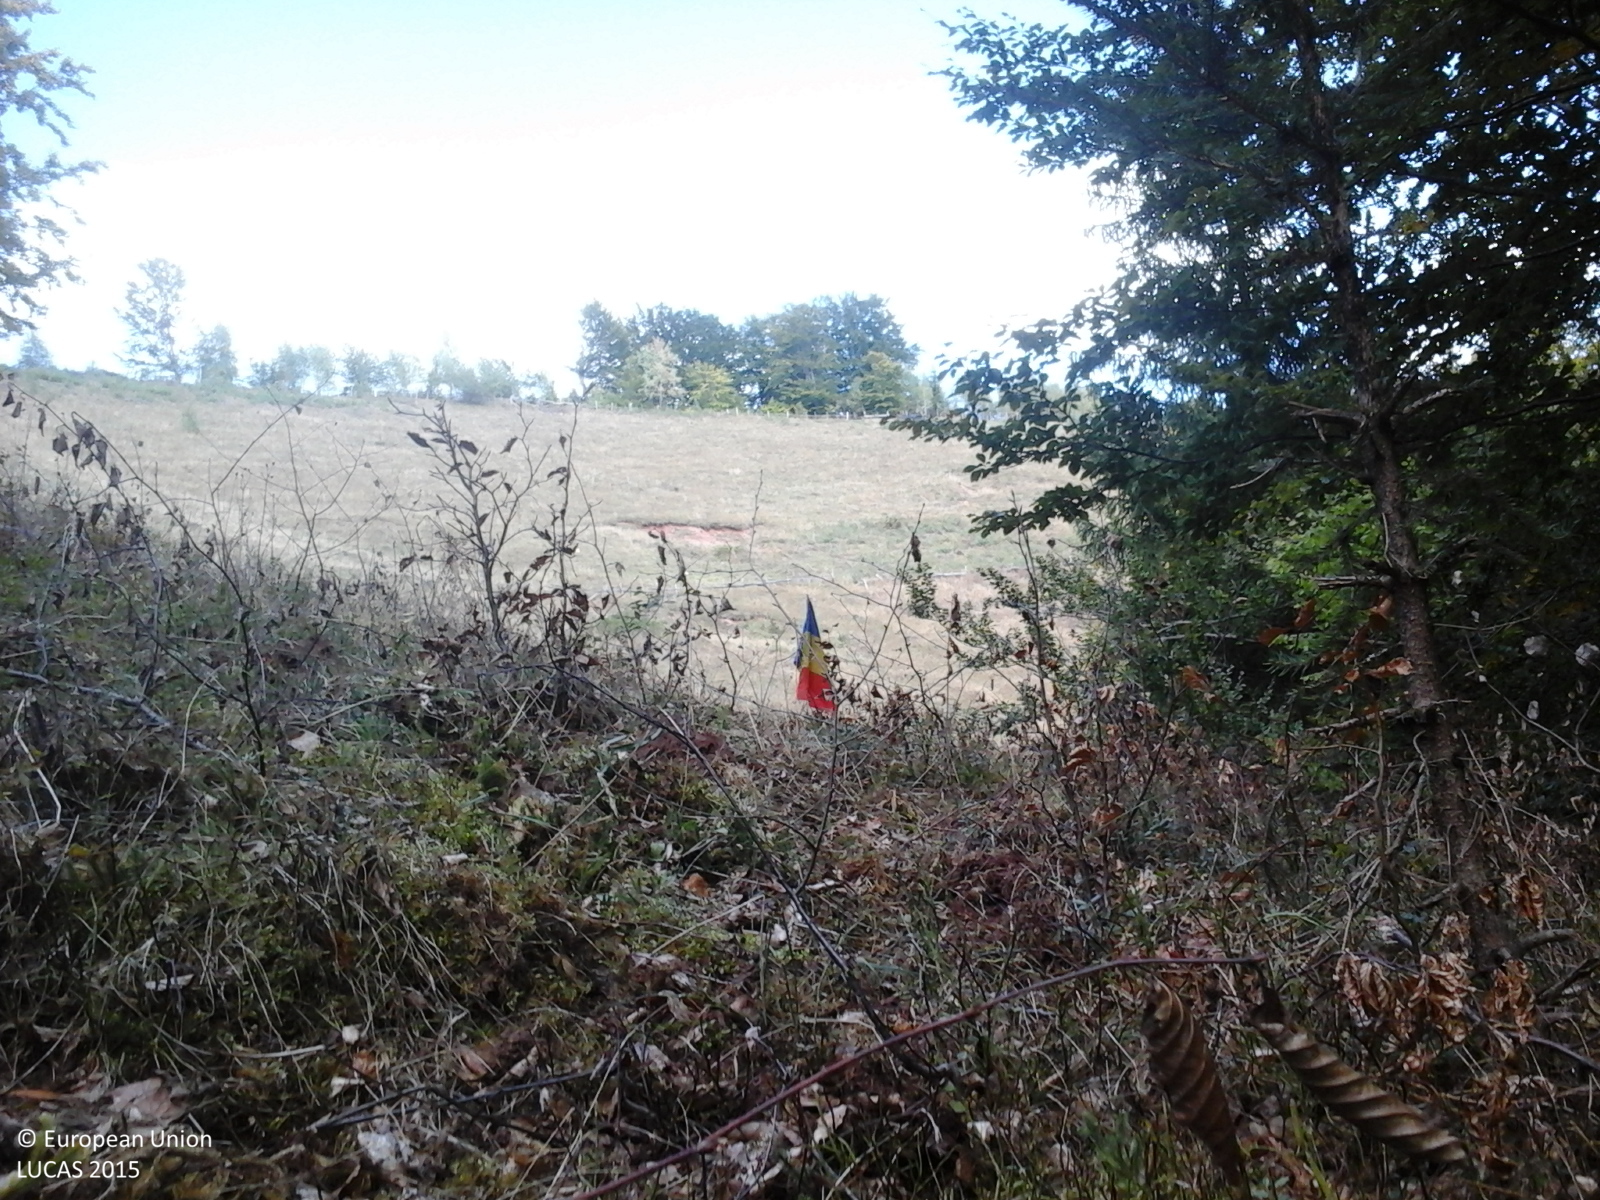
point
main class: Woodland
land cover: Broadleaved woodland
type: mesophytic deciduous forest
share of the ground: > 75 %
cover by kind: broadleaved forest trees 100 %
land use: Forestry
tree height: > 5 m
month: October
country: RO
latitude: 46.3876
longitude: 22.8913
